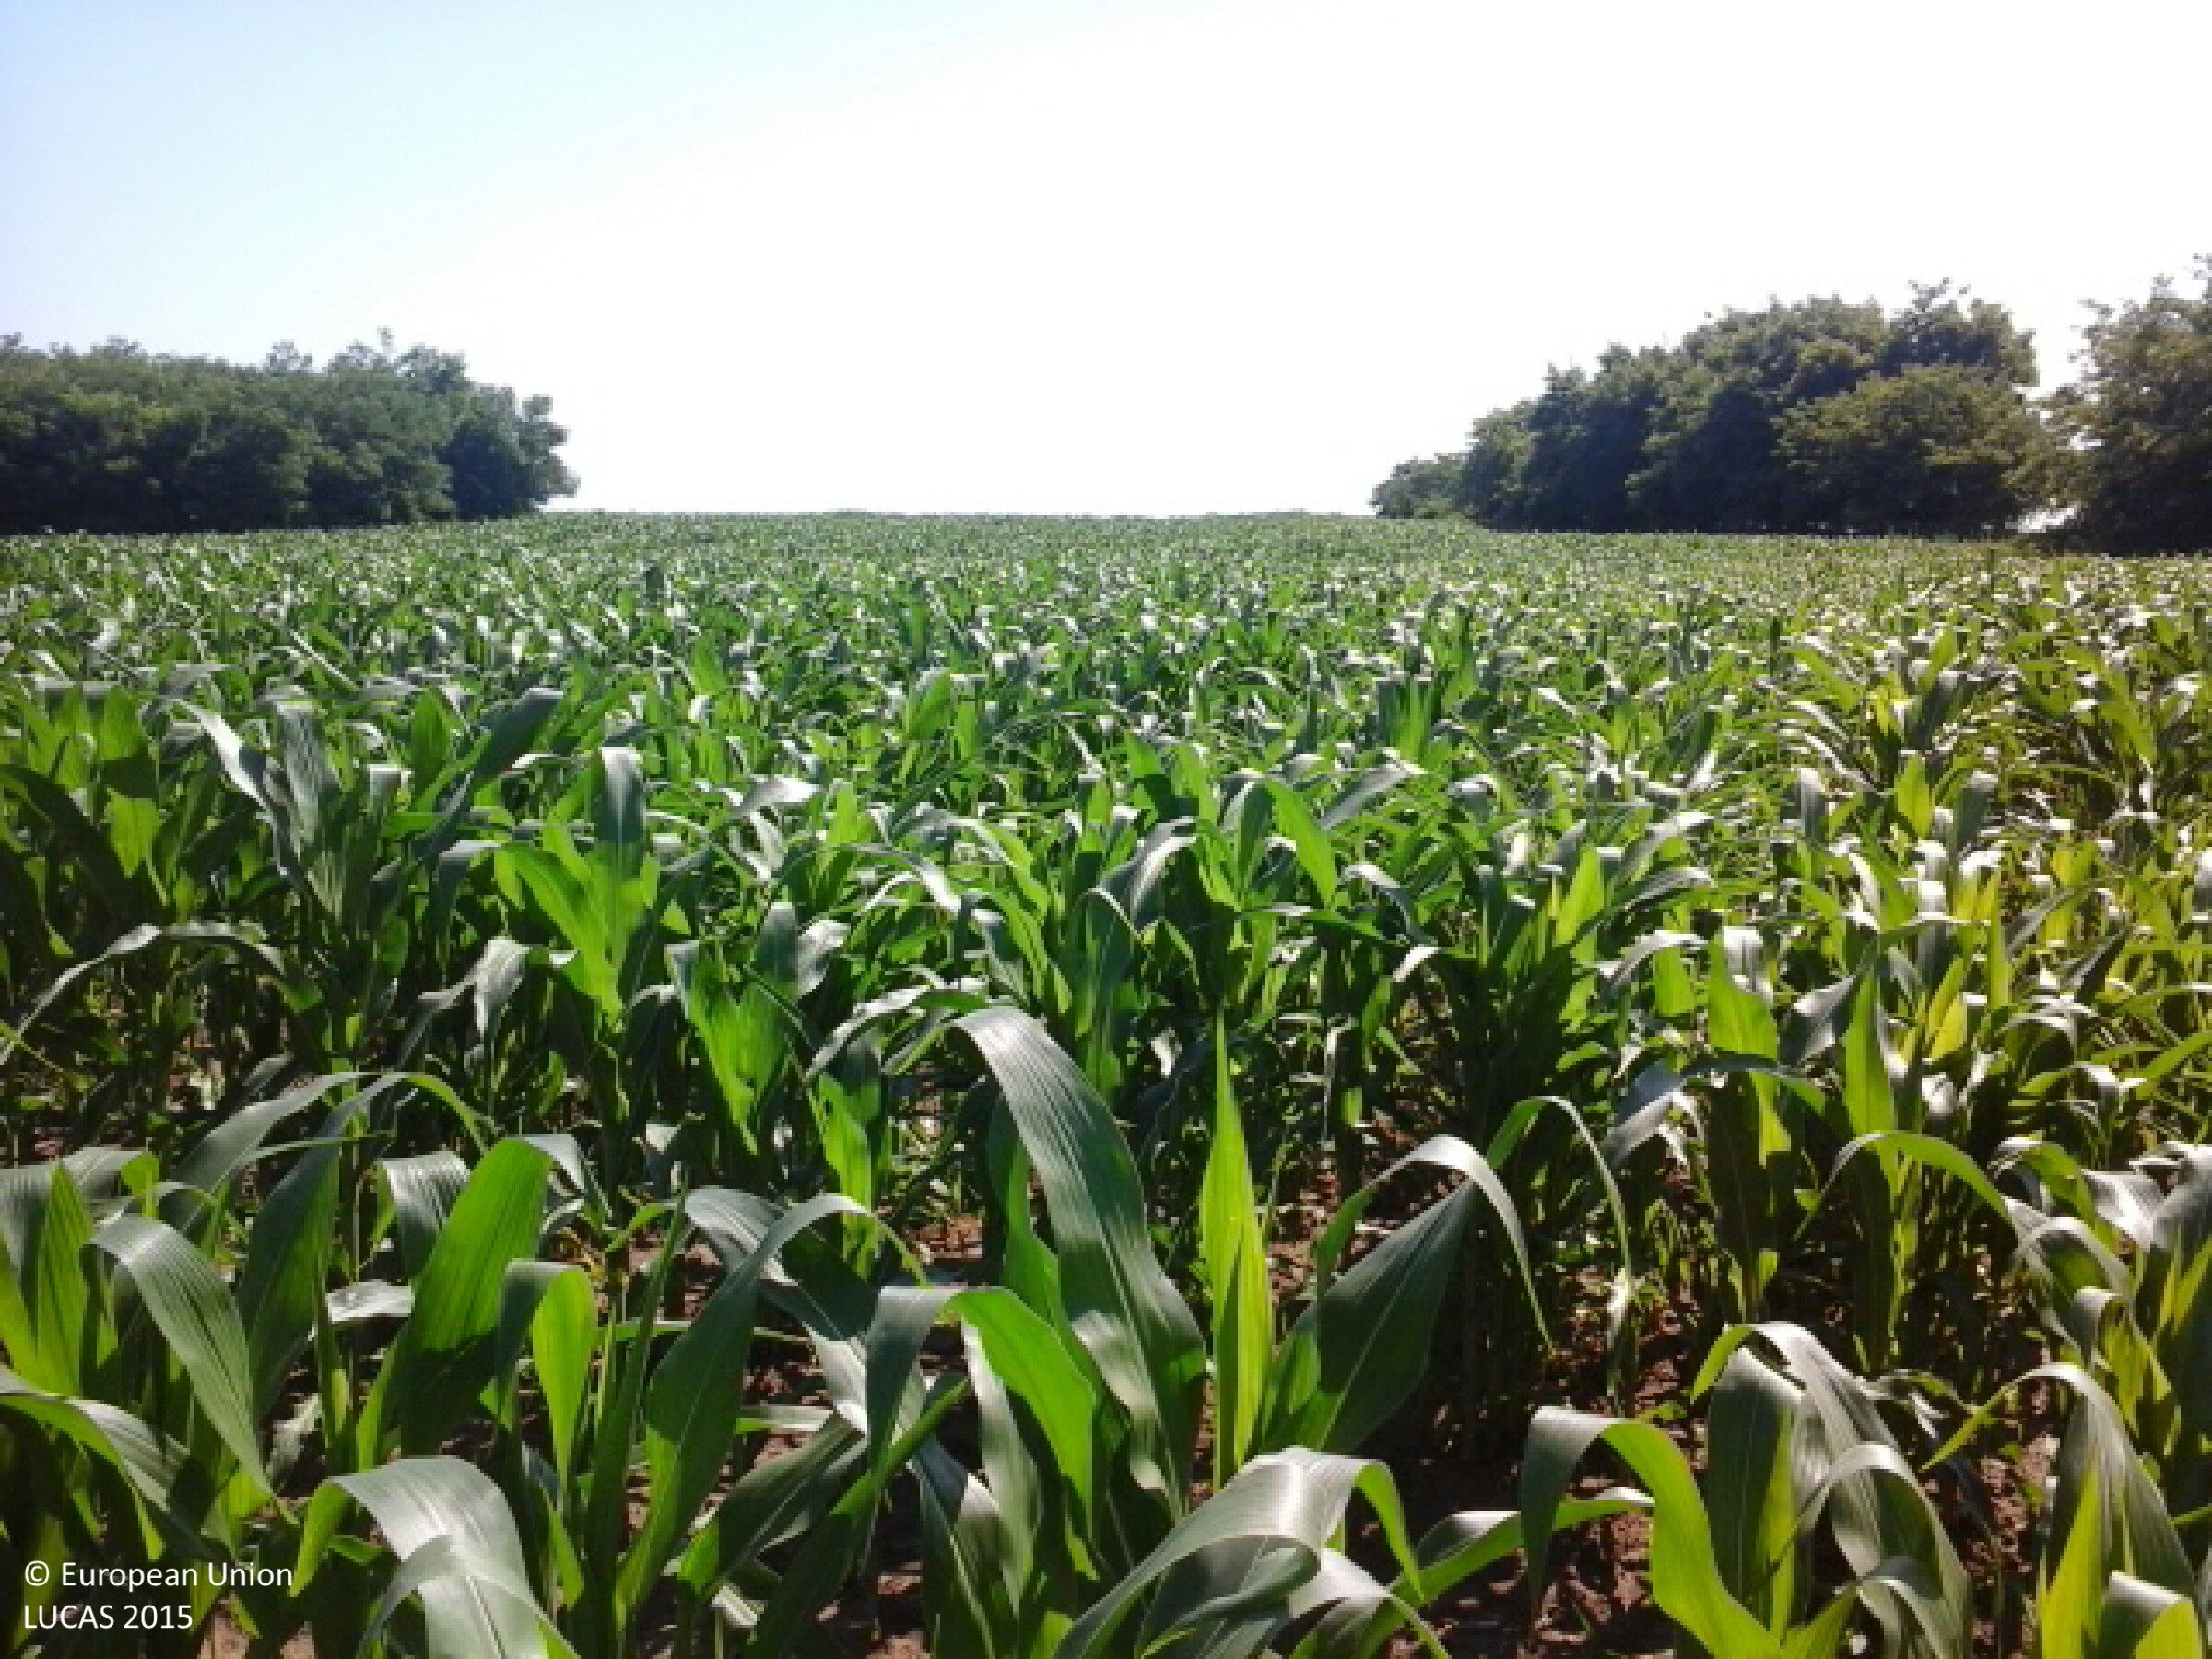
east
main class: Cropland
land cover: Maize
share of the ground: 50 - 75 %
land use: Agriculture (excluding fallow land and kitchen gardens)
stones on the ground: < 10 %
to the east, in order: Maize; Broadleaved woodland; Sunflower; Grassland with sparse tree/shrub cover; Maize
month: June
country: HU
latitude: 47.7950
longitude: 21.7285
